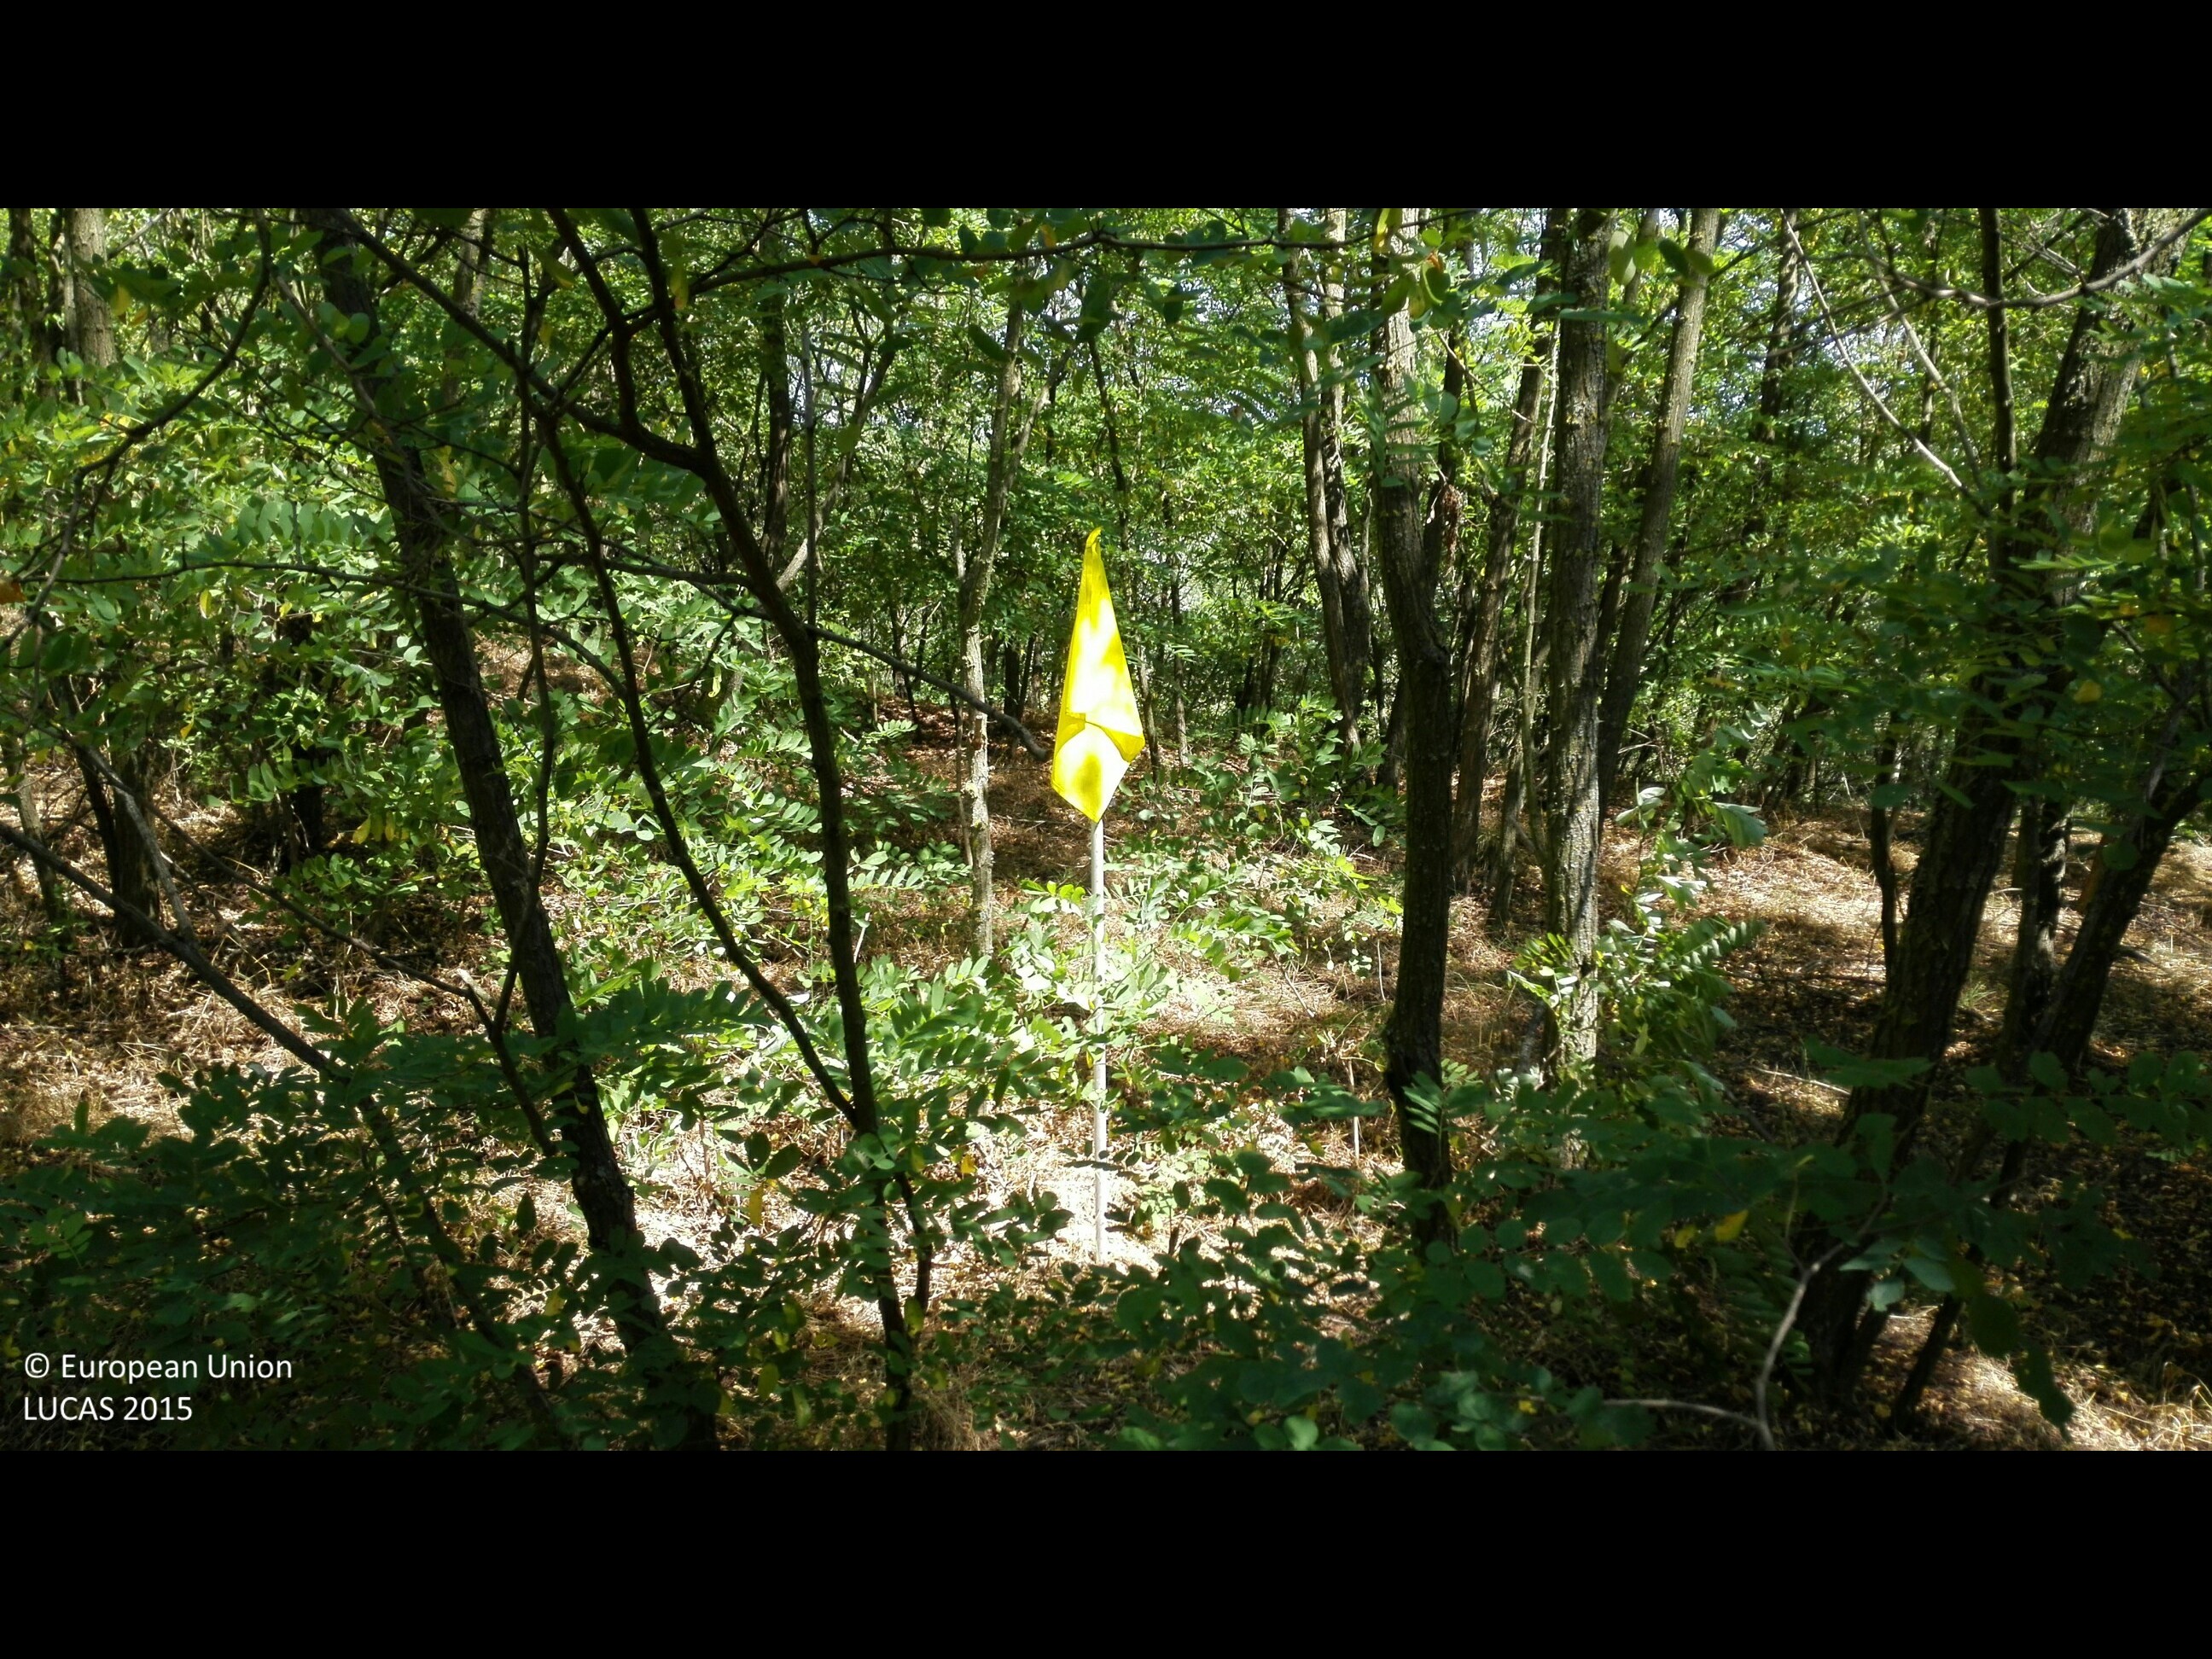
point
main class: Woodland
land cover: Broadleaved woodland
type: exotic forest
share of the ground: > 75 %
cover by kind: broadleaved forest trees 95 %, herbaceous plants 5 %
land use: Forestry
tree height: > 5 m
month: August
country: HU
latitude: 47.4706
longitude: 21.8693
